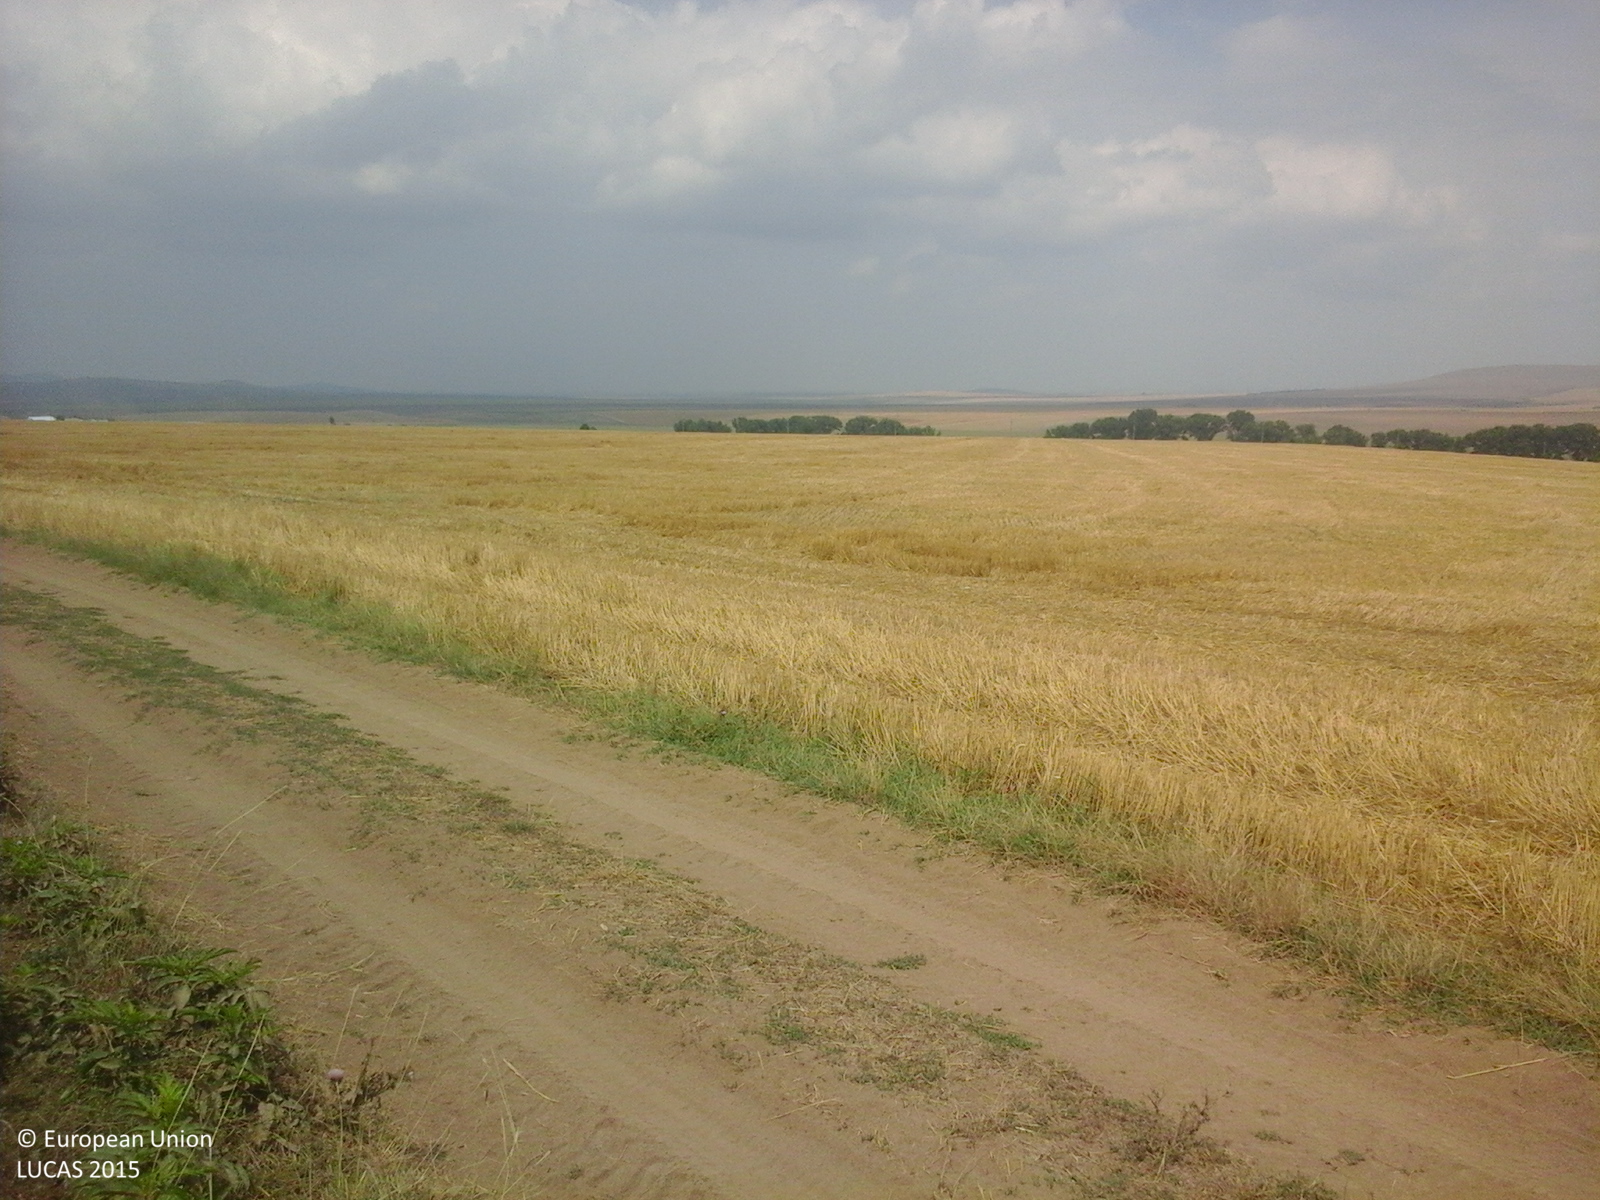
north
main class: Cropland
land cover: Maize
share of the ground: > 75 %
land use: Agriculture (excluding fallow land and kitchen gardens)
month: July
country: RO
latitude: 44.9546
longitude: 28.6267
